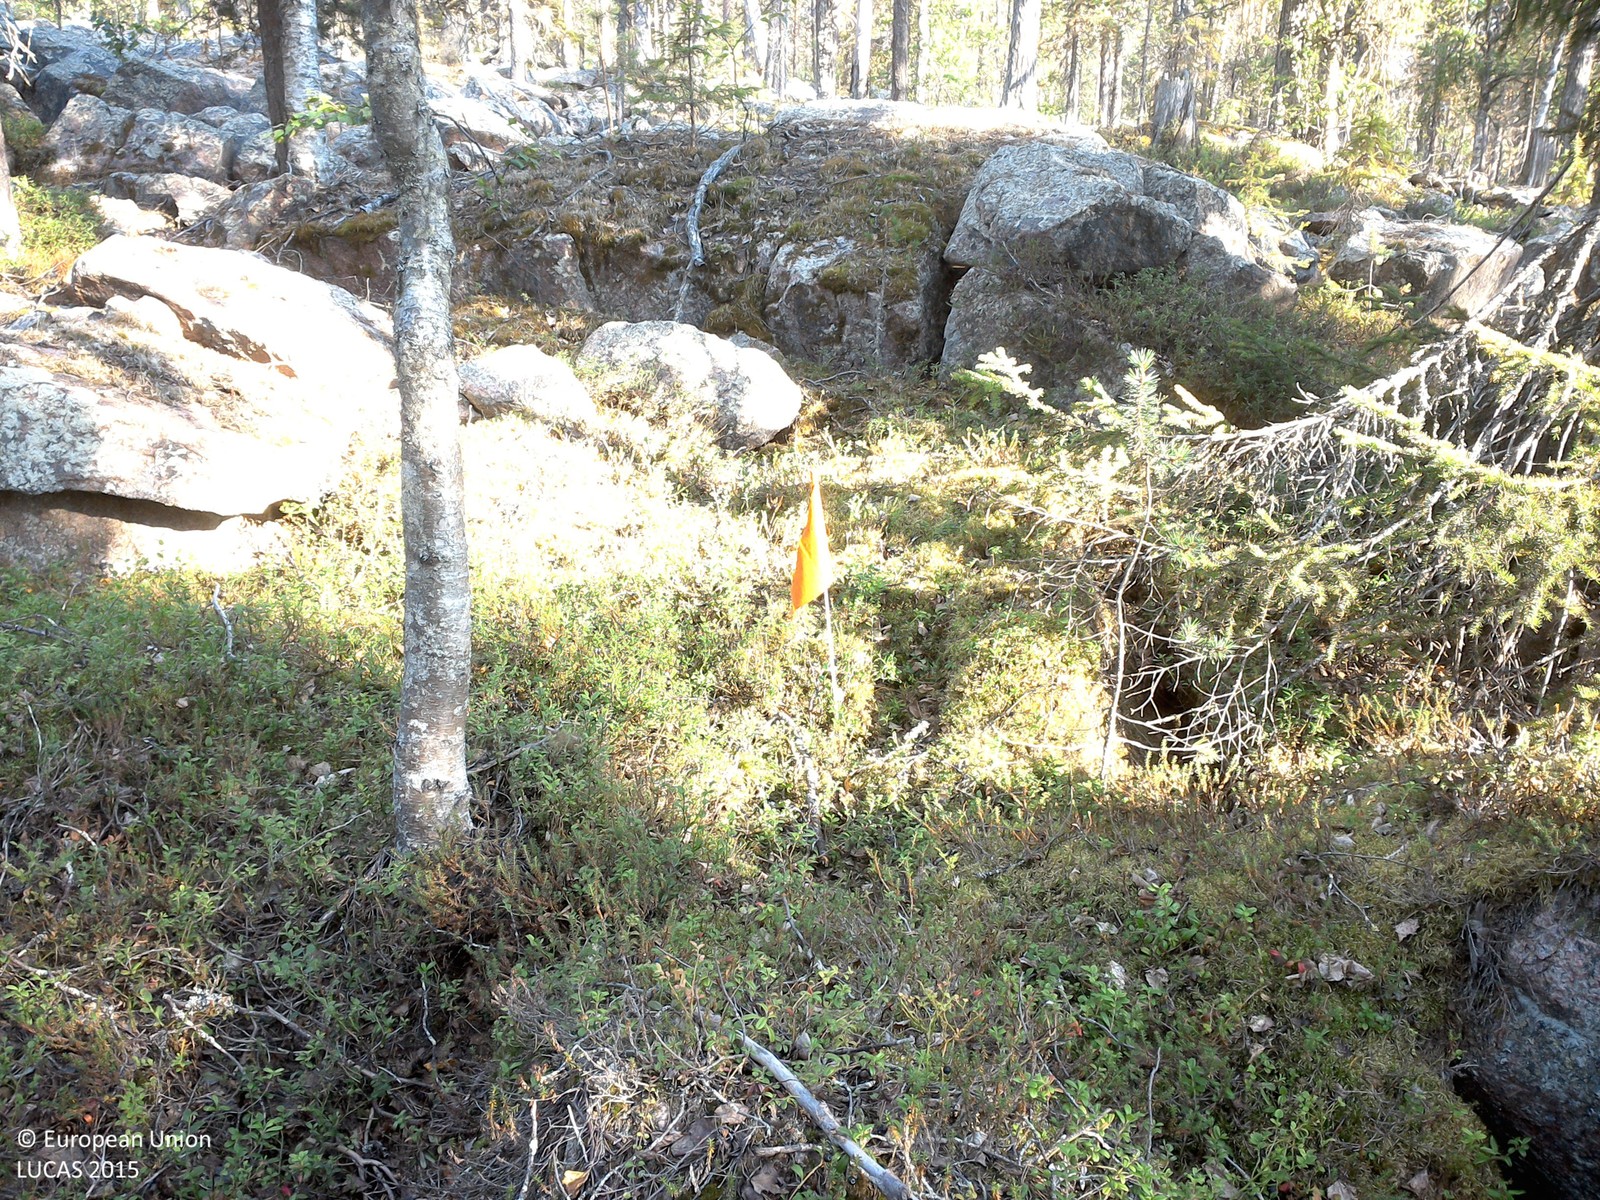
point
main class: Woodland
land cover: Pine dominated mixed woodland
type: boreal forest
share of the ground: 25 - 50 %
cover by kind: lichens and mosses 40 %, coniferous forest trees 25 %, shrubs 15 %, broadleaved forest trees 10 %, unconsolidated bare surface 10 %
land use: Forestry
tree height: > 5 m
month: August
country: SE
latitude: 67.1523
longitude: 22.4946
